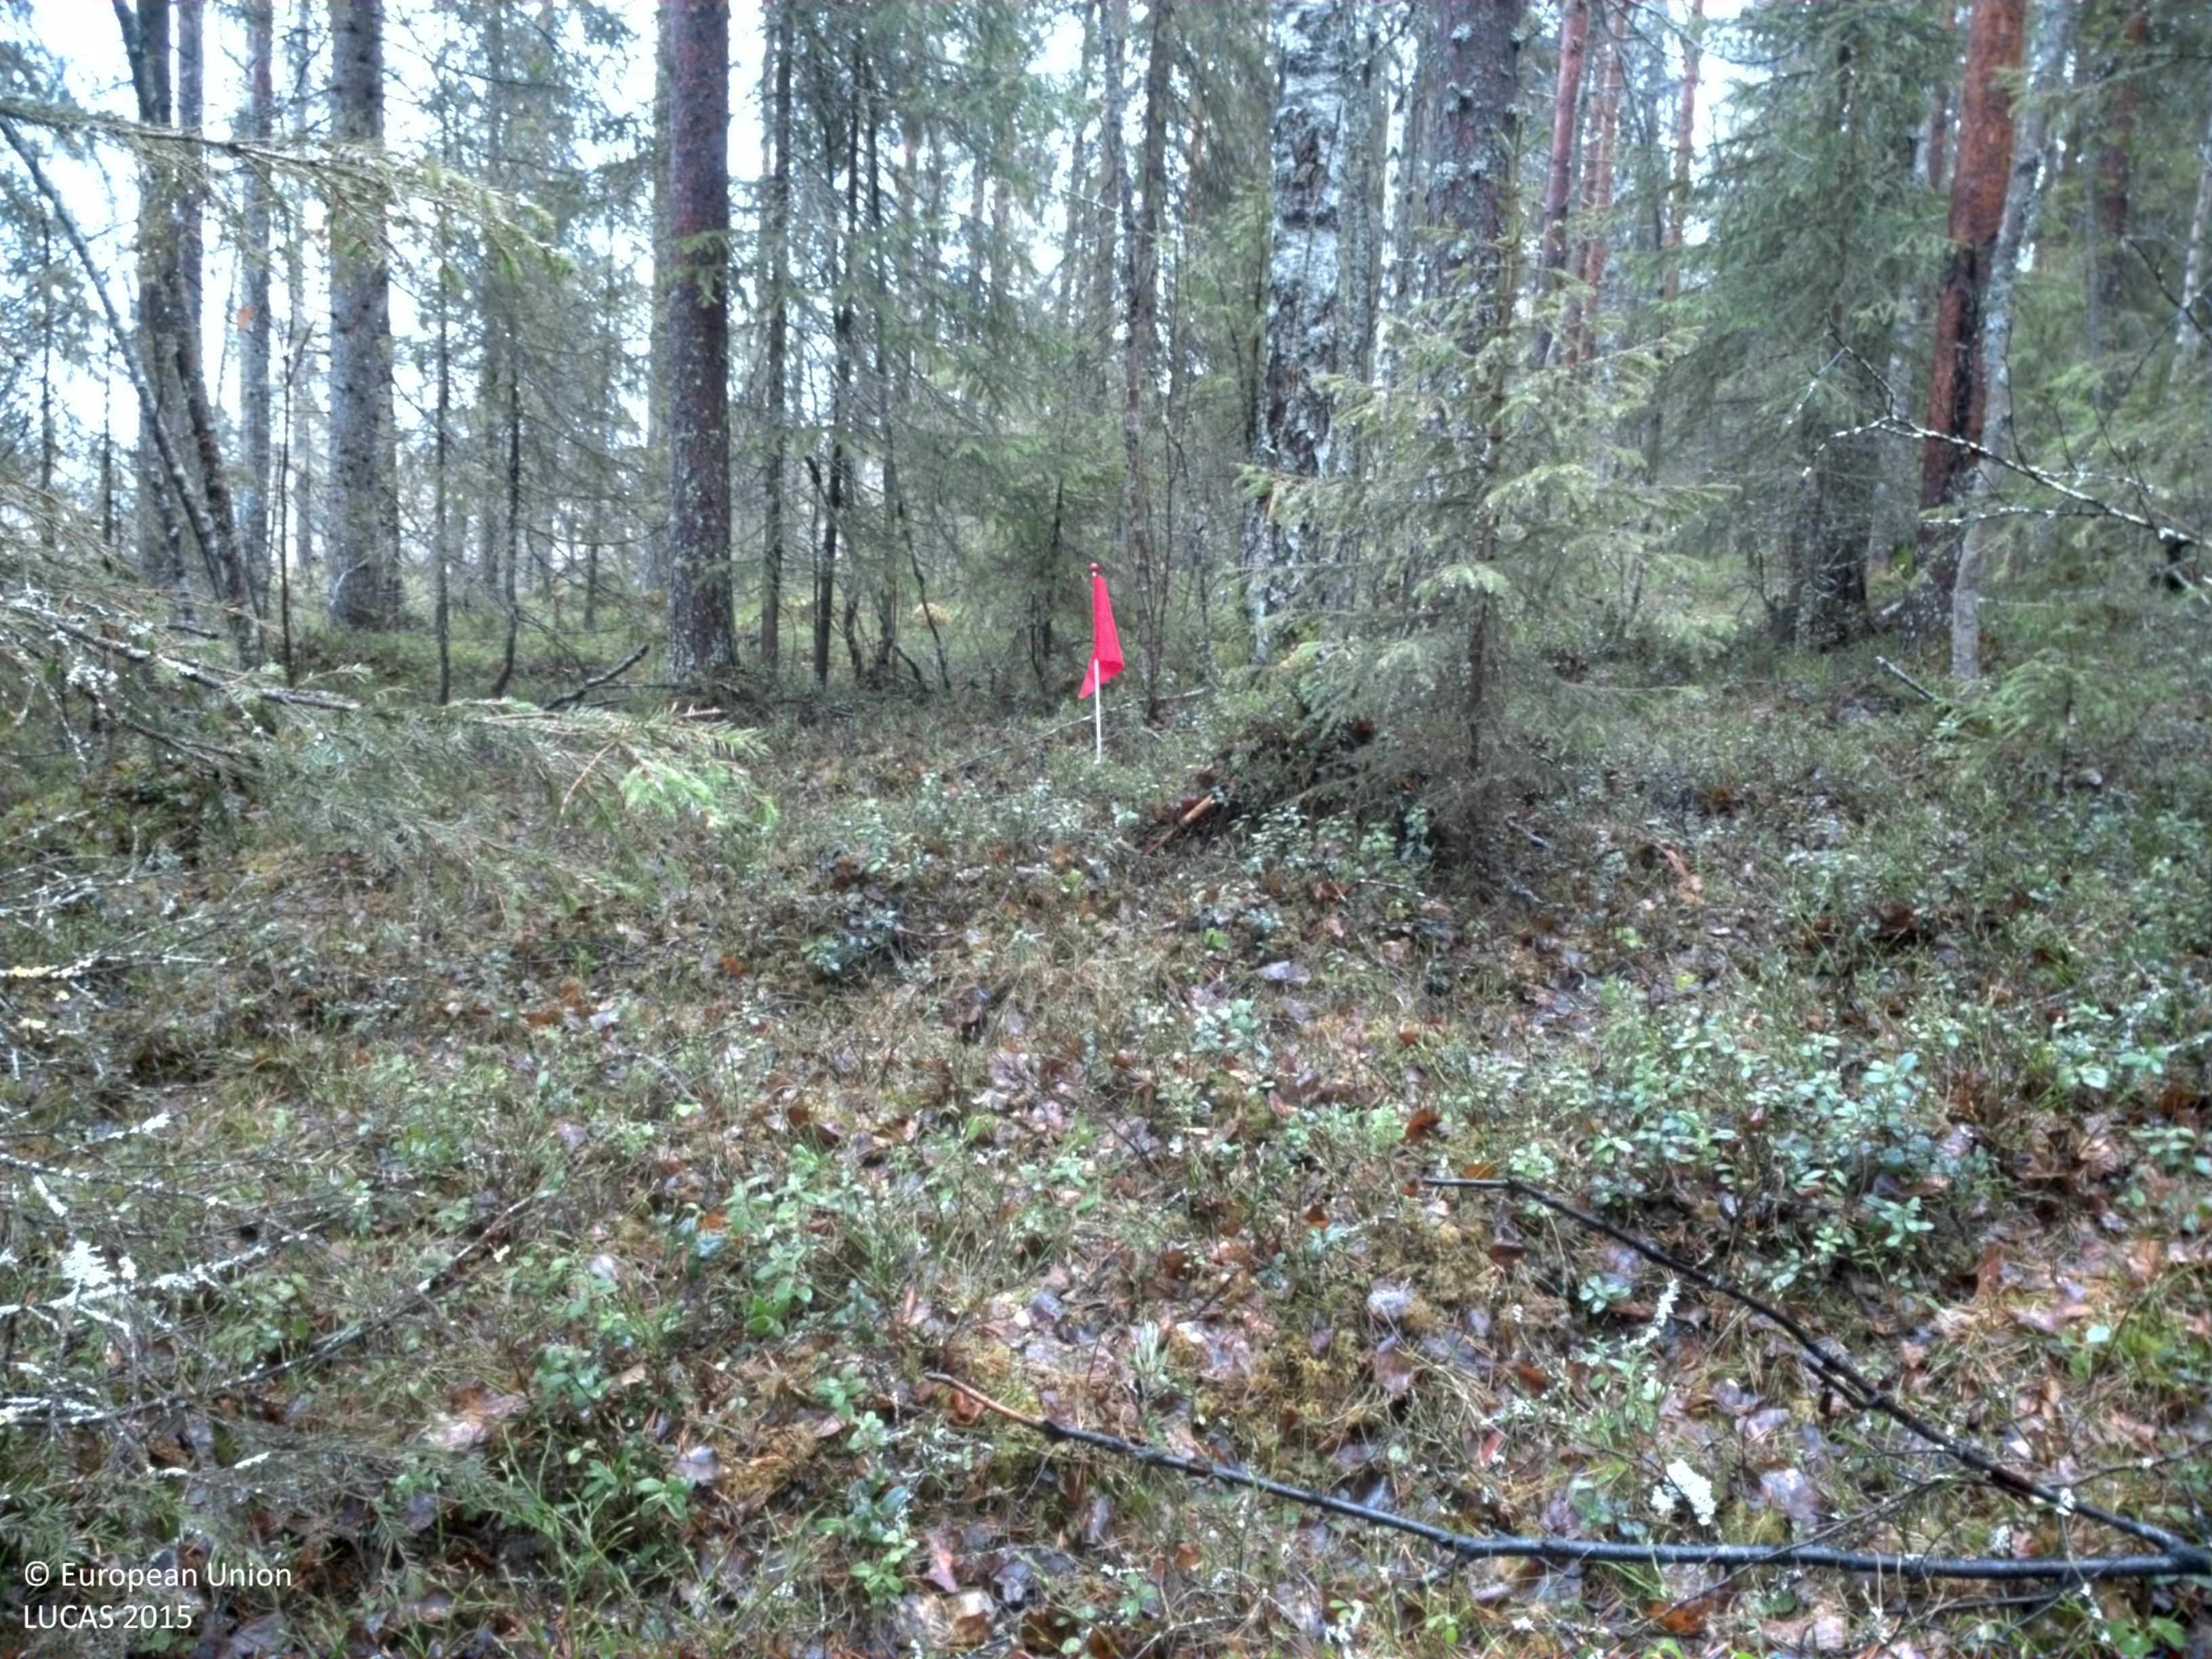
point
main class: Woodland
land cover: Pine dominated coniferous woodland
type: boreal forest
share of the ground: 50 - 75 %
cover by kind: coniferous forest trees 70 %, shrubs 15 %, lichens and mosses 10 %, broadleaved forest trees 5 %
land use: Forestry
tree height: > 5 m
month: May
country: SE
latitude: 66.5370
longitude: 23.3280
